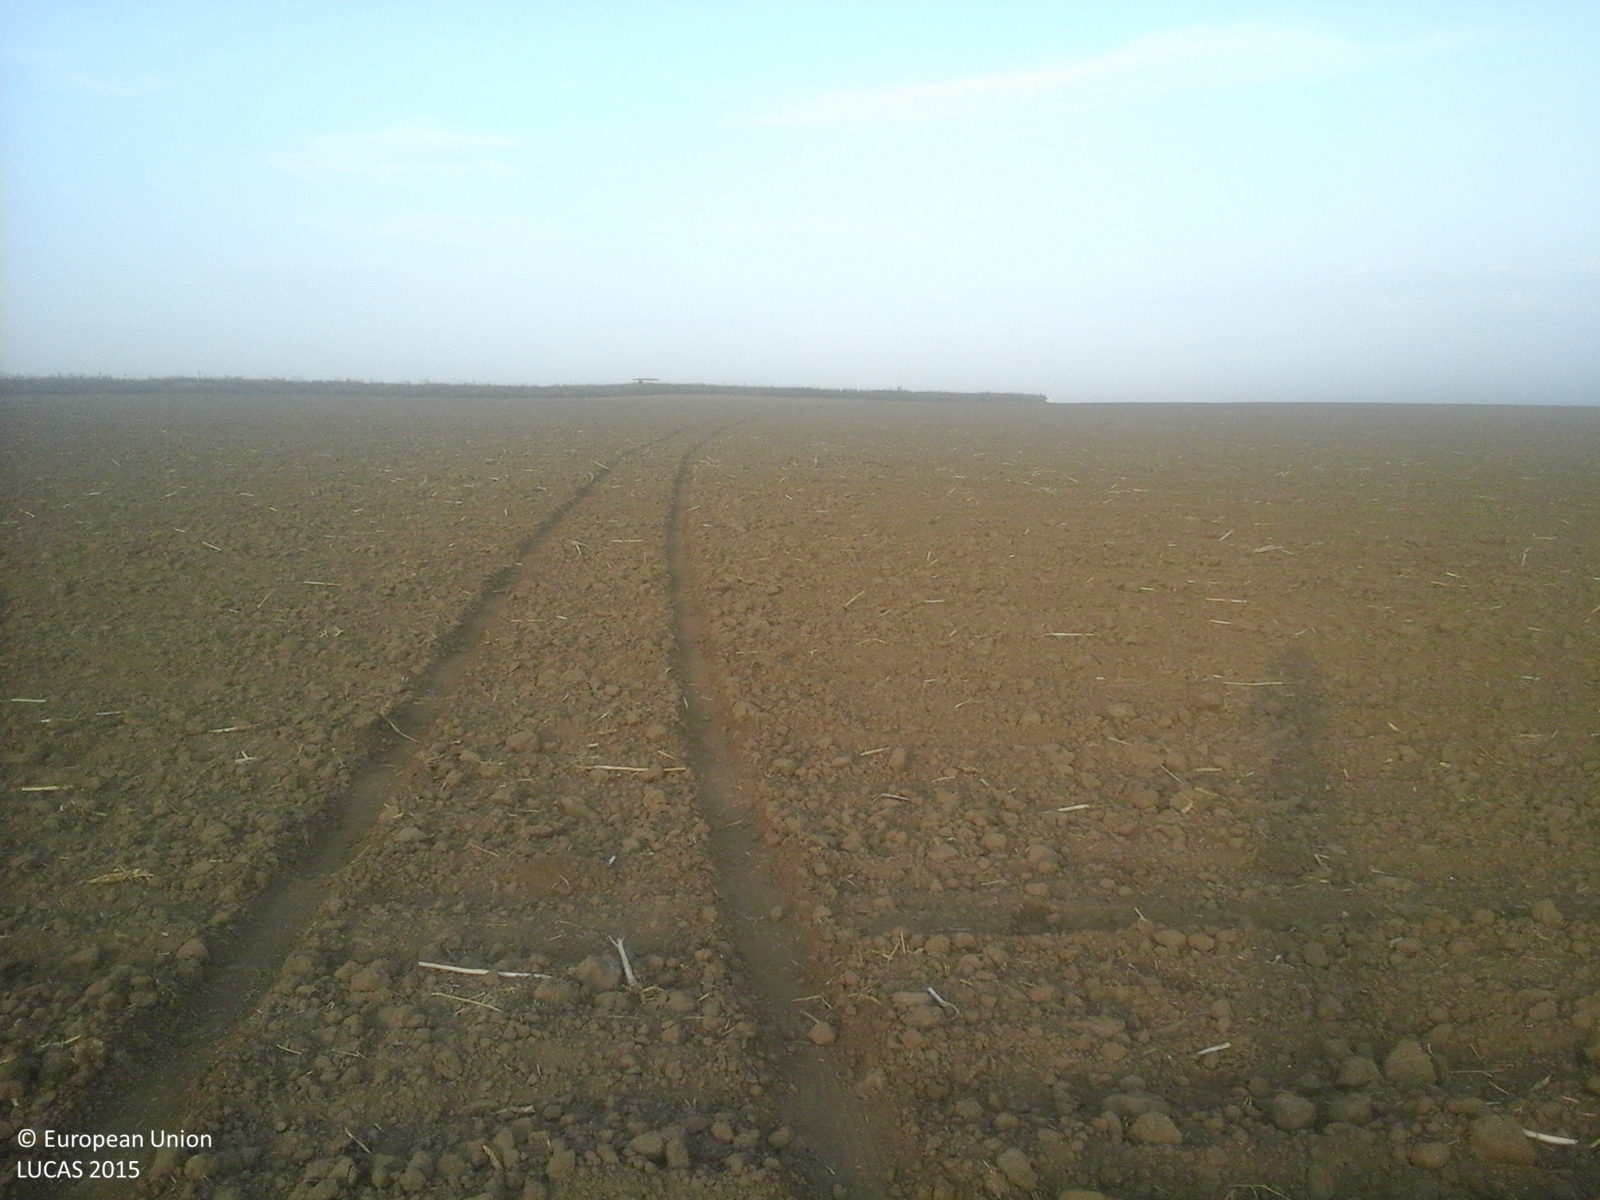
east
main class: Cropland
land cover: Rape and turnip rape
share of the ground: < 10 %
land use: Agriculture (excluding fallow land and kitchen gardens)
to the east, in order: Rape and turnip rape; Shruby margins; Tracks; Inland fresh running water
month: August
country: RO
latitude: 44.1235
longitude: 28.1149
